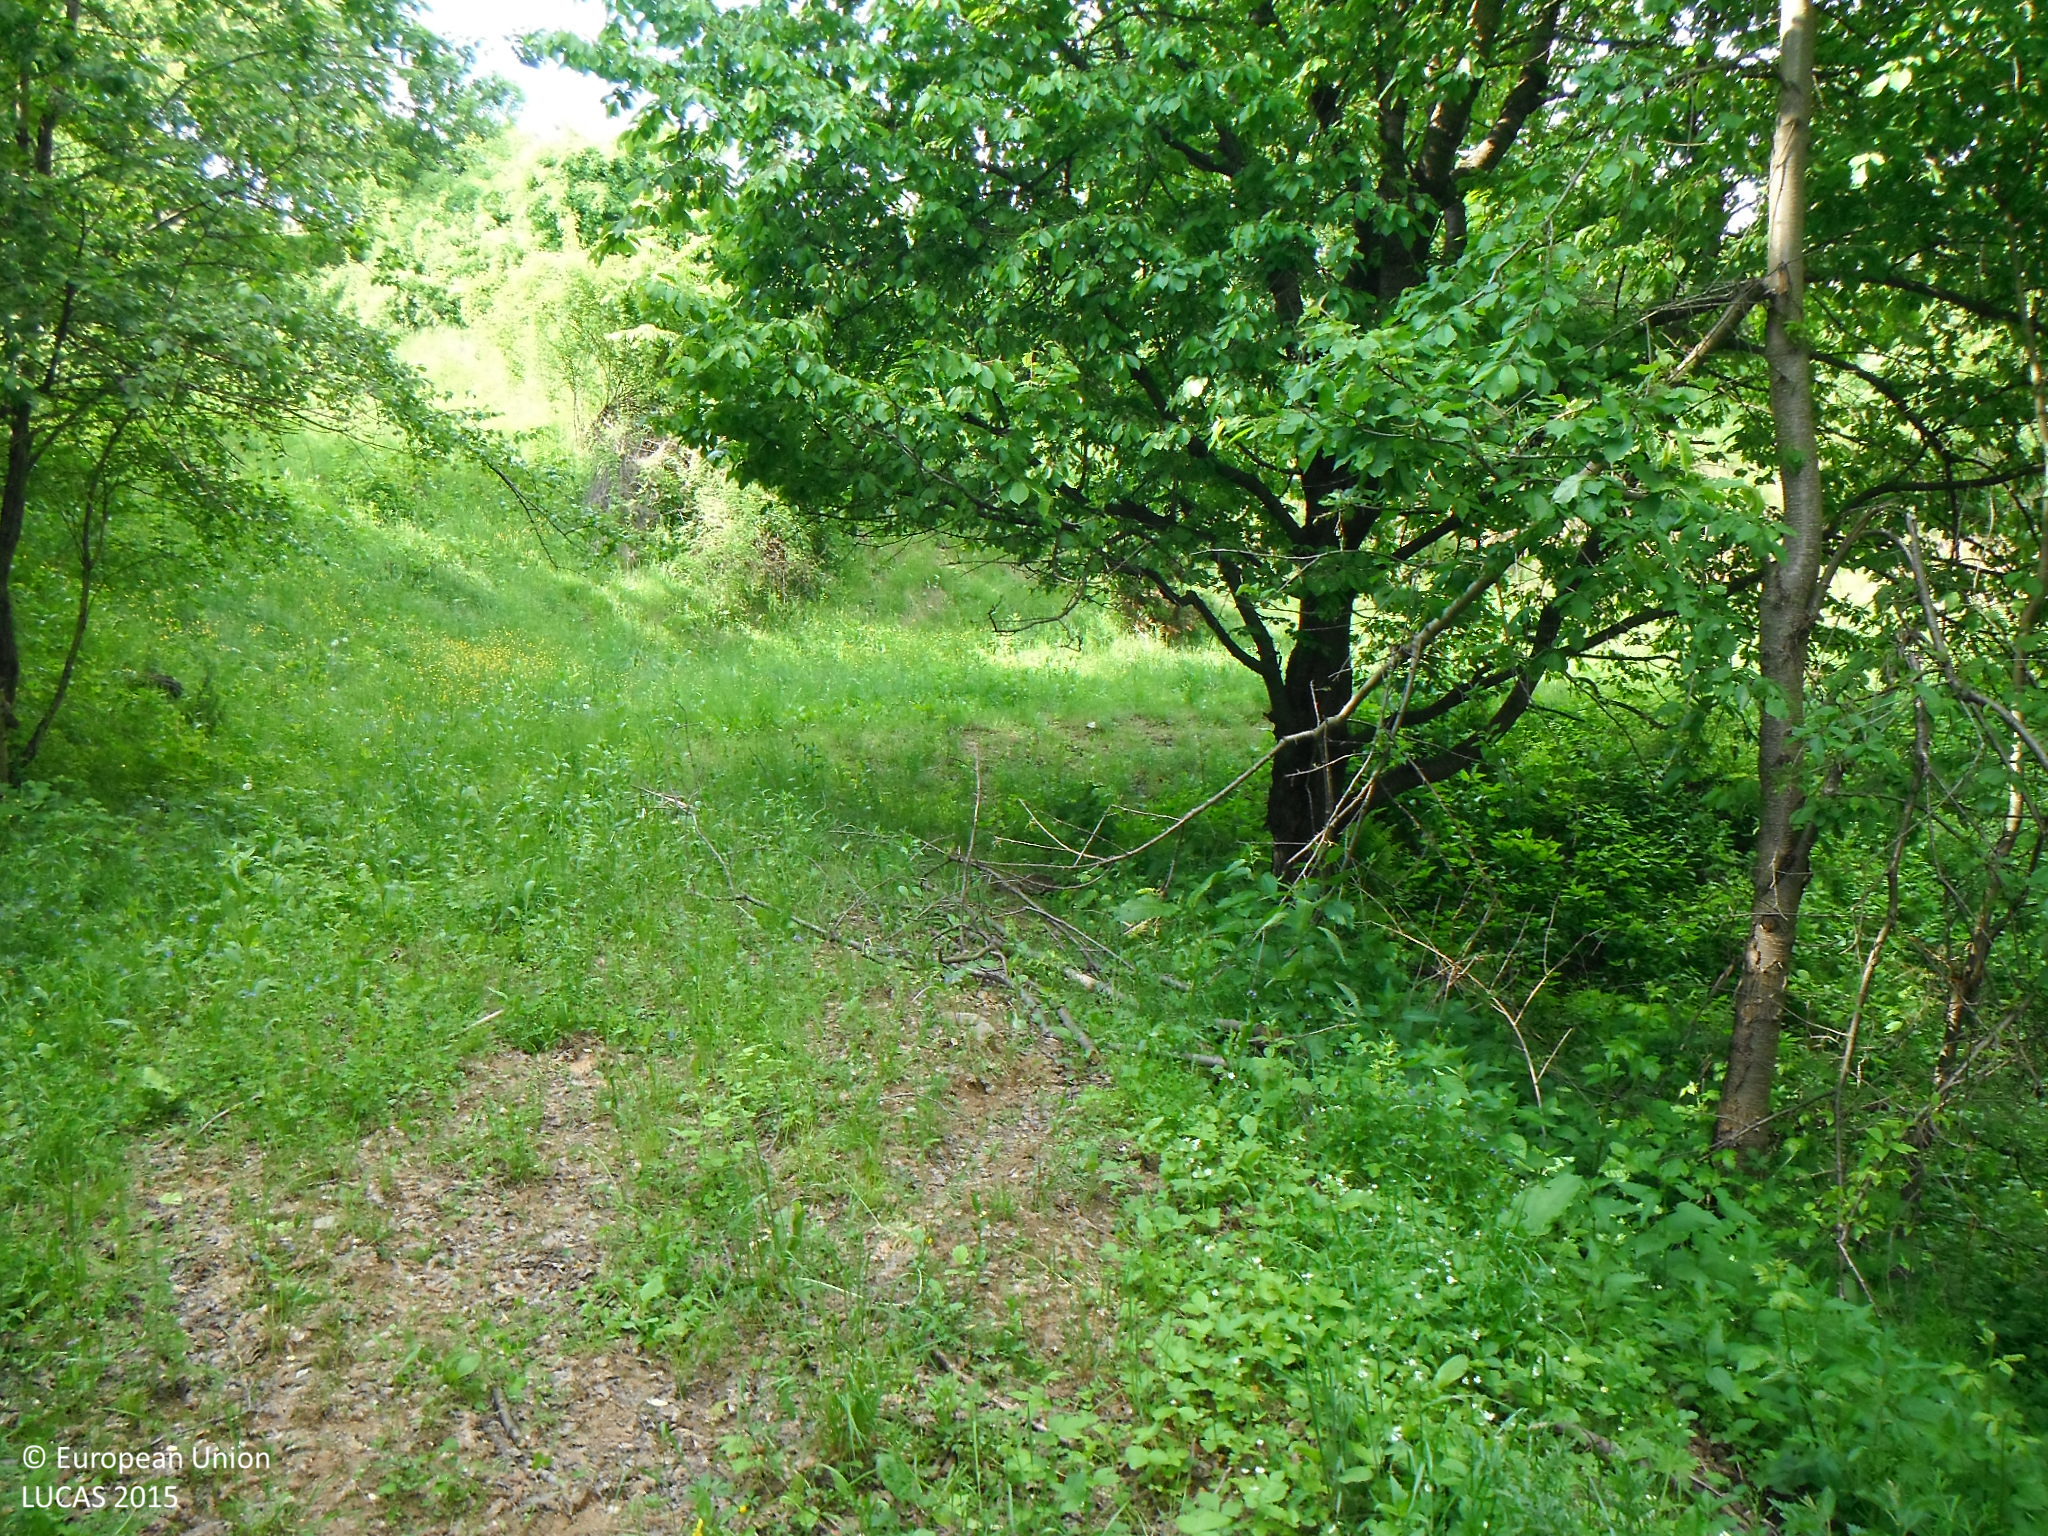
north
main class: Woodland
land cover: Broadleaved woodland
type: mesophytic deciduous forest
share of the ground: > 75 %
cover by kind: broadleaved forest trees 80 %, herbaceous plants 20 %
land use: Forestry
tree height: > 5 m
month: May
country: SK
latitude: 48.5331
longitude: 19.5457
